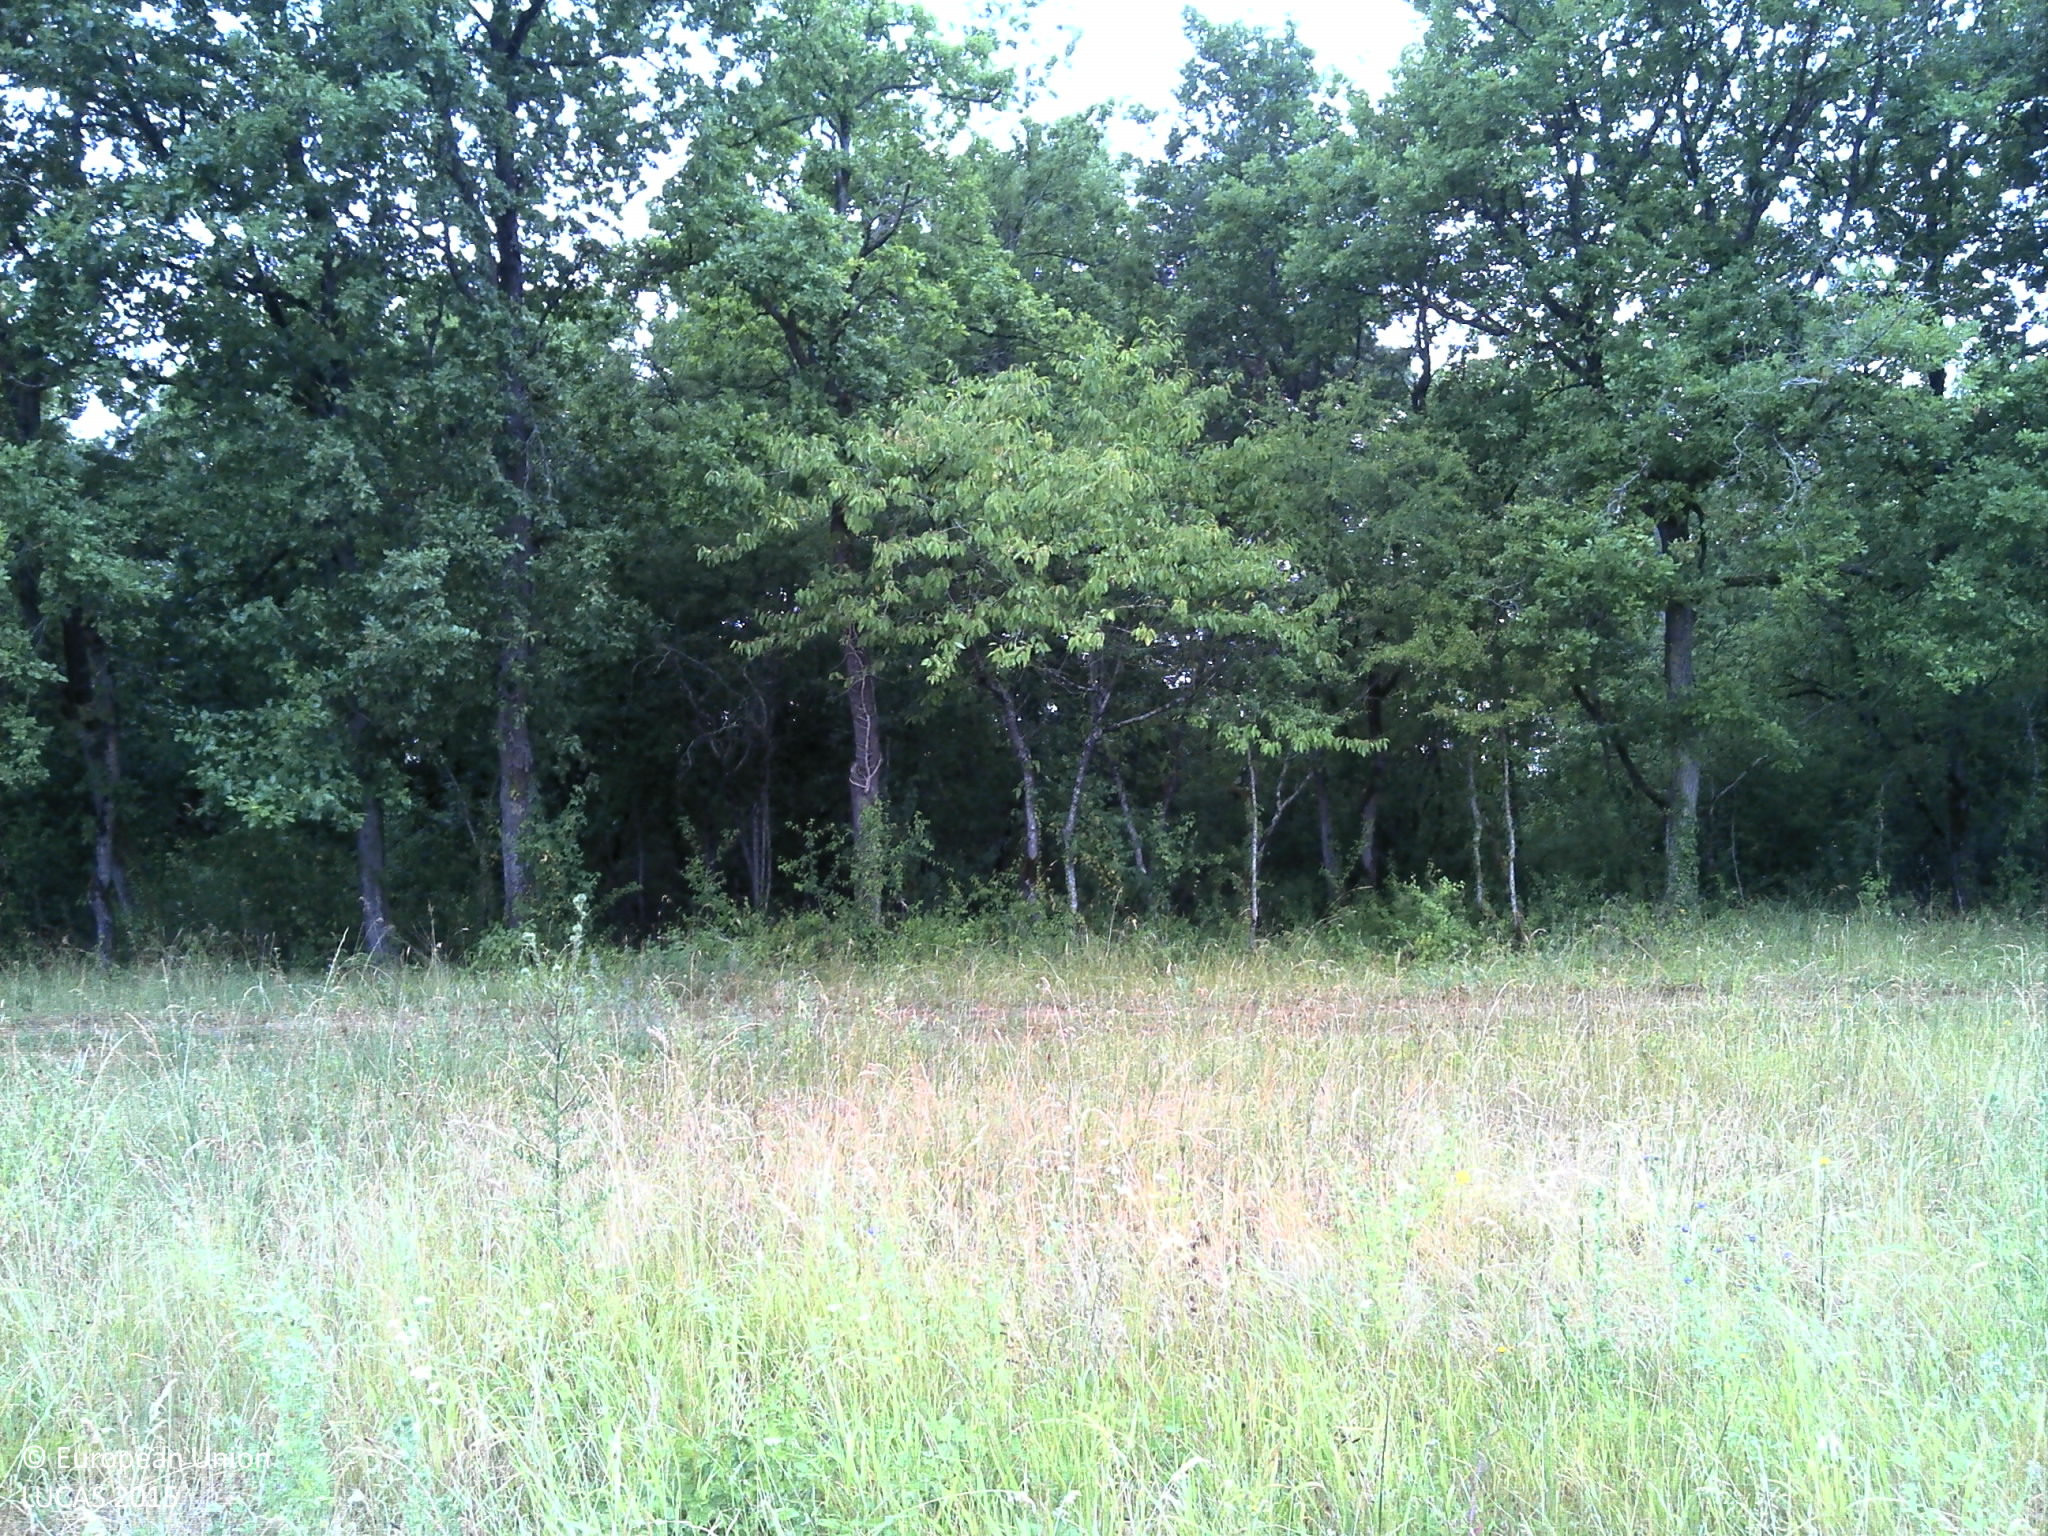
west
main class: Grassland
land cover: Grassland without tree/shrub cover
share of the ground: > 75 %
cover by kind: herbaceous plants 100 %
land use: Agriculture (excluding fallow land and kitchen gardens)
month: July
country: FR
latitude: 48.2543
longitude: 2.4606
